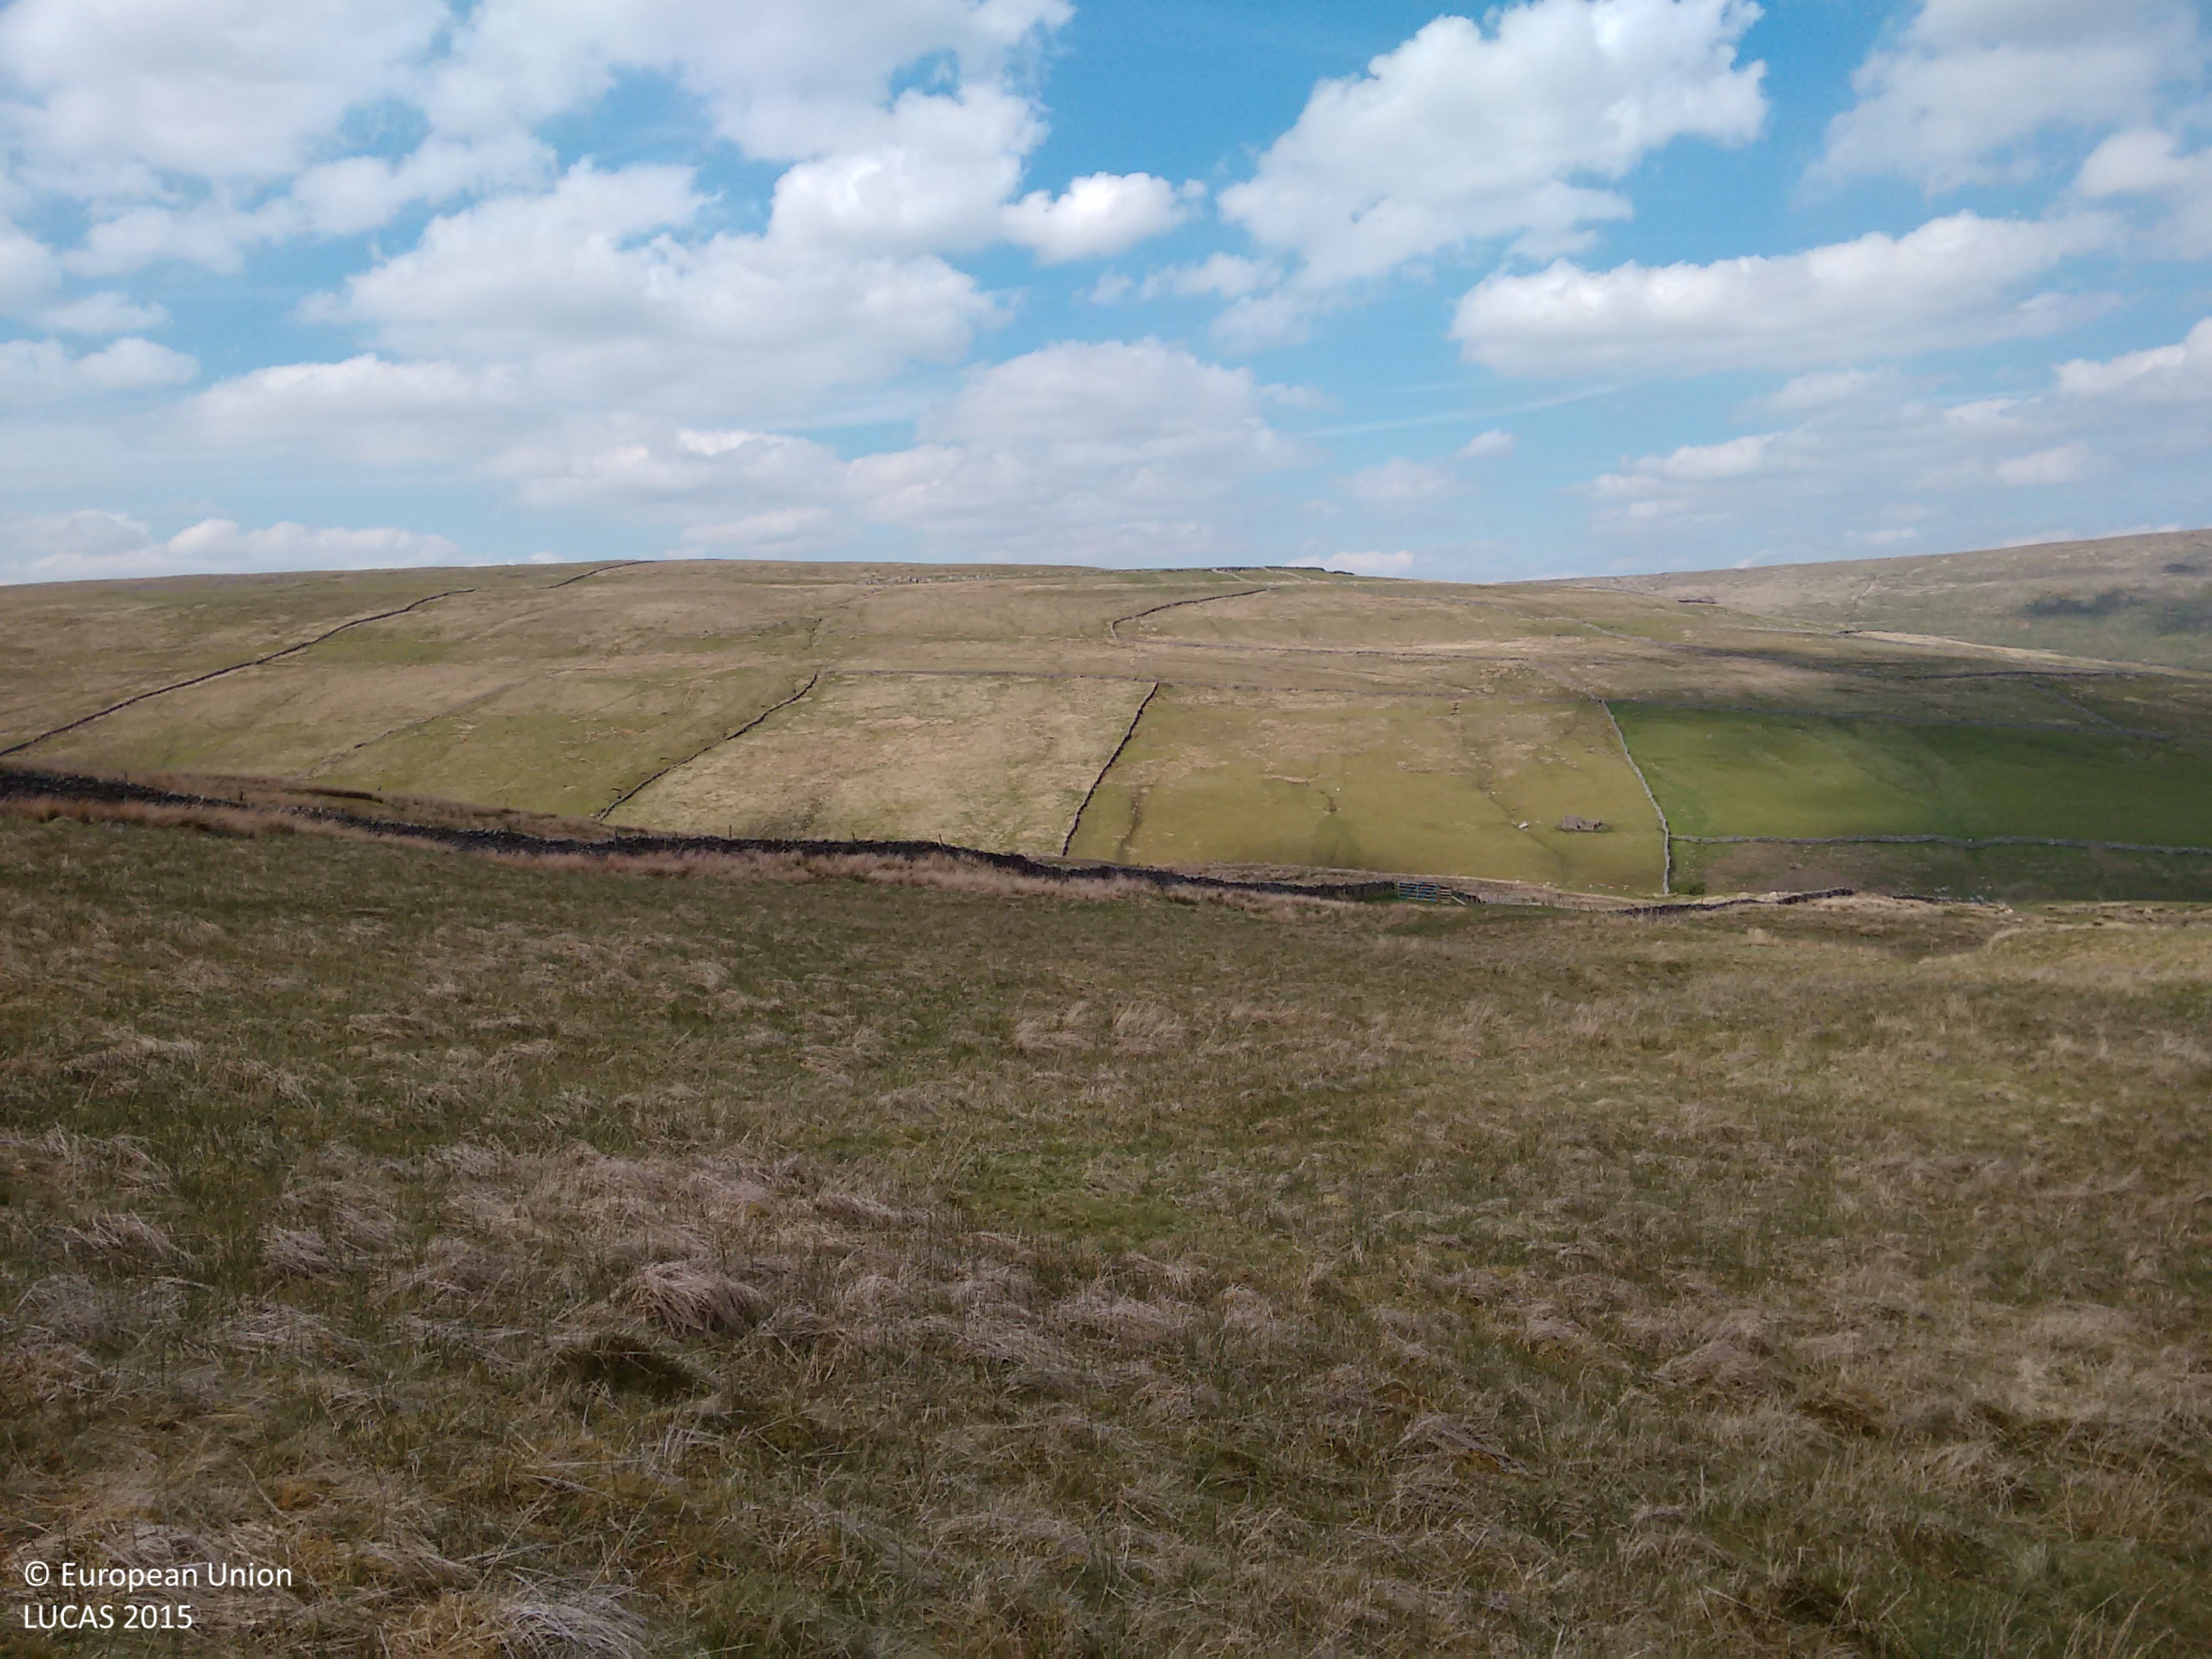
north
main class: Grassland
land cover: Grassland without tree/shrub cover
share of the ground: > 75 %
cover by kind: herbaceous plants 100 %
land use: Agriculture (excluding fallow land and kitchen gardens)
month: June
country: GB
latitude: 54.1822
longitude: -2.2106
